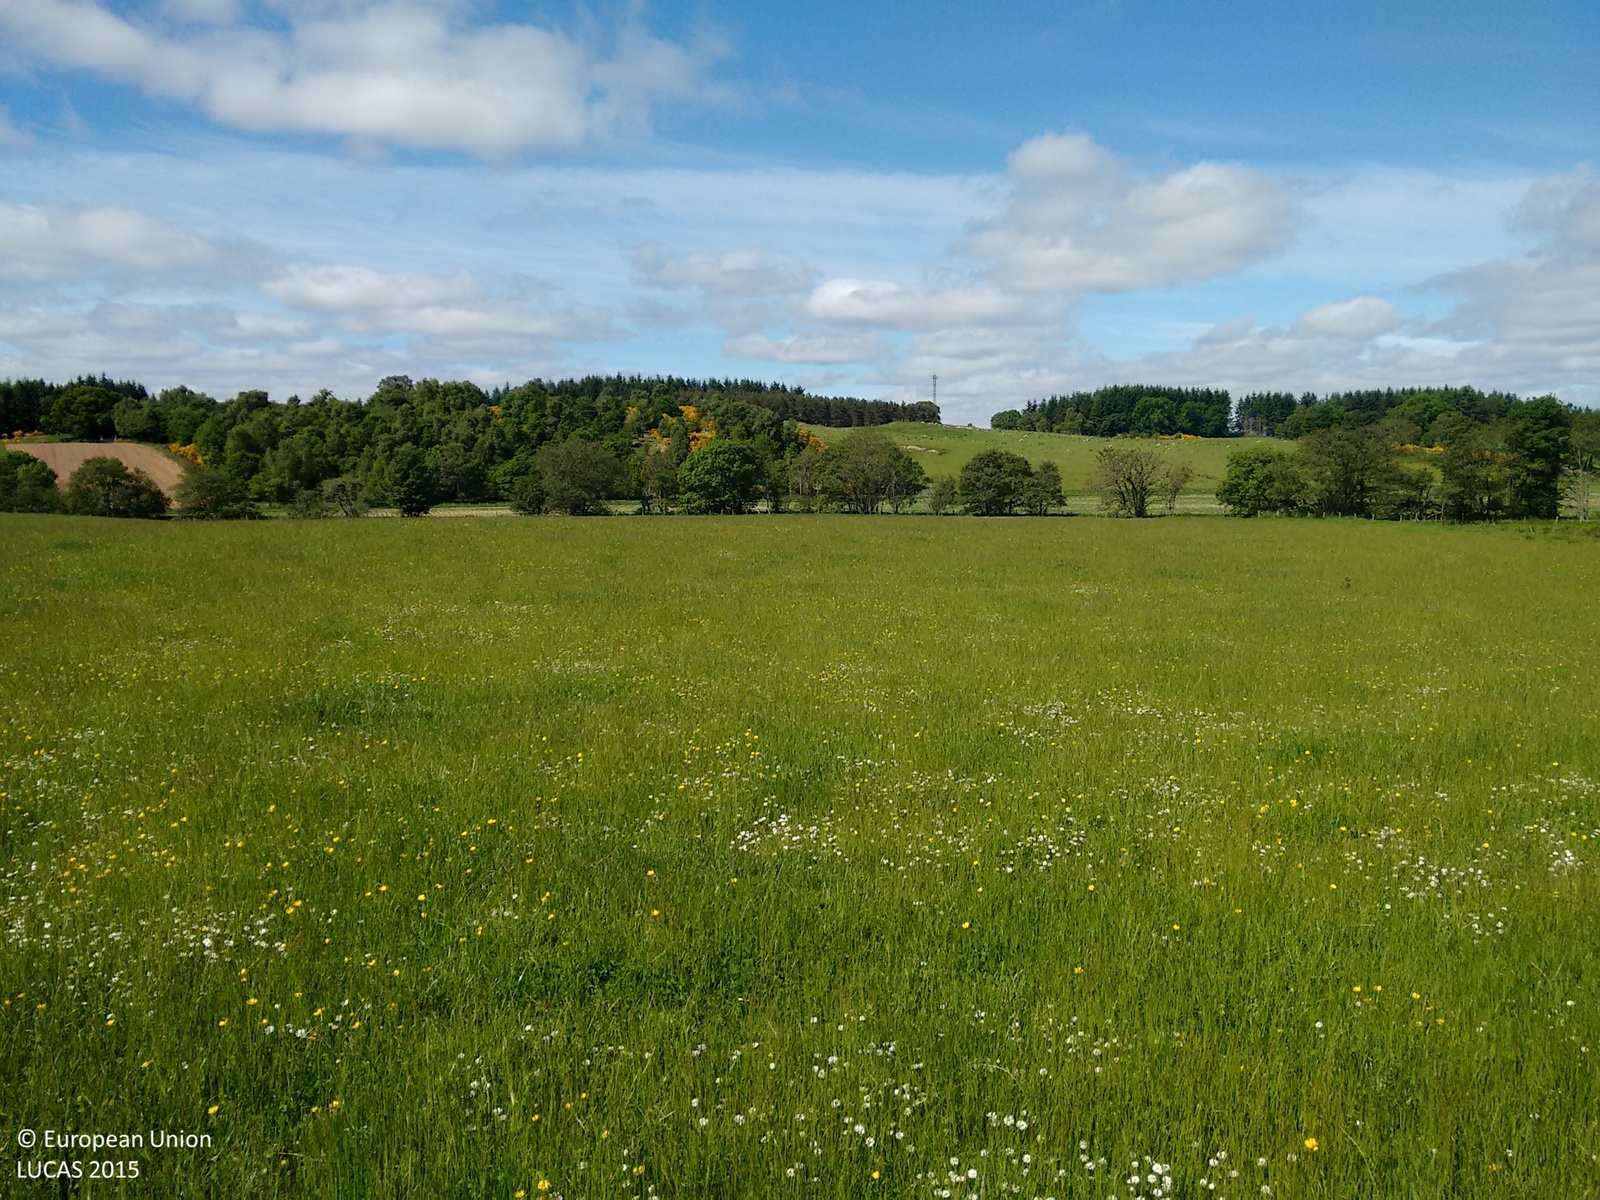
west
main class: Grassland
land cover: Grassland without tree/shrub cover
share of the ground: > 75 %
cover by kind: herbaceous plants 100 %
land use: Agriculture (excluding fallow land and kitchen gardens)
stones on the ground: < 10 %
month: June
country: GB
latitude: 56.6435
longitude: -3.6281
